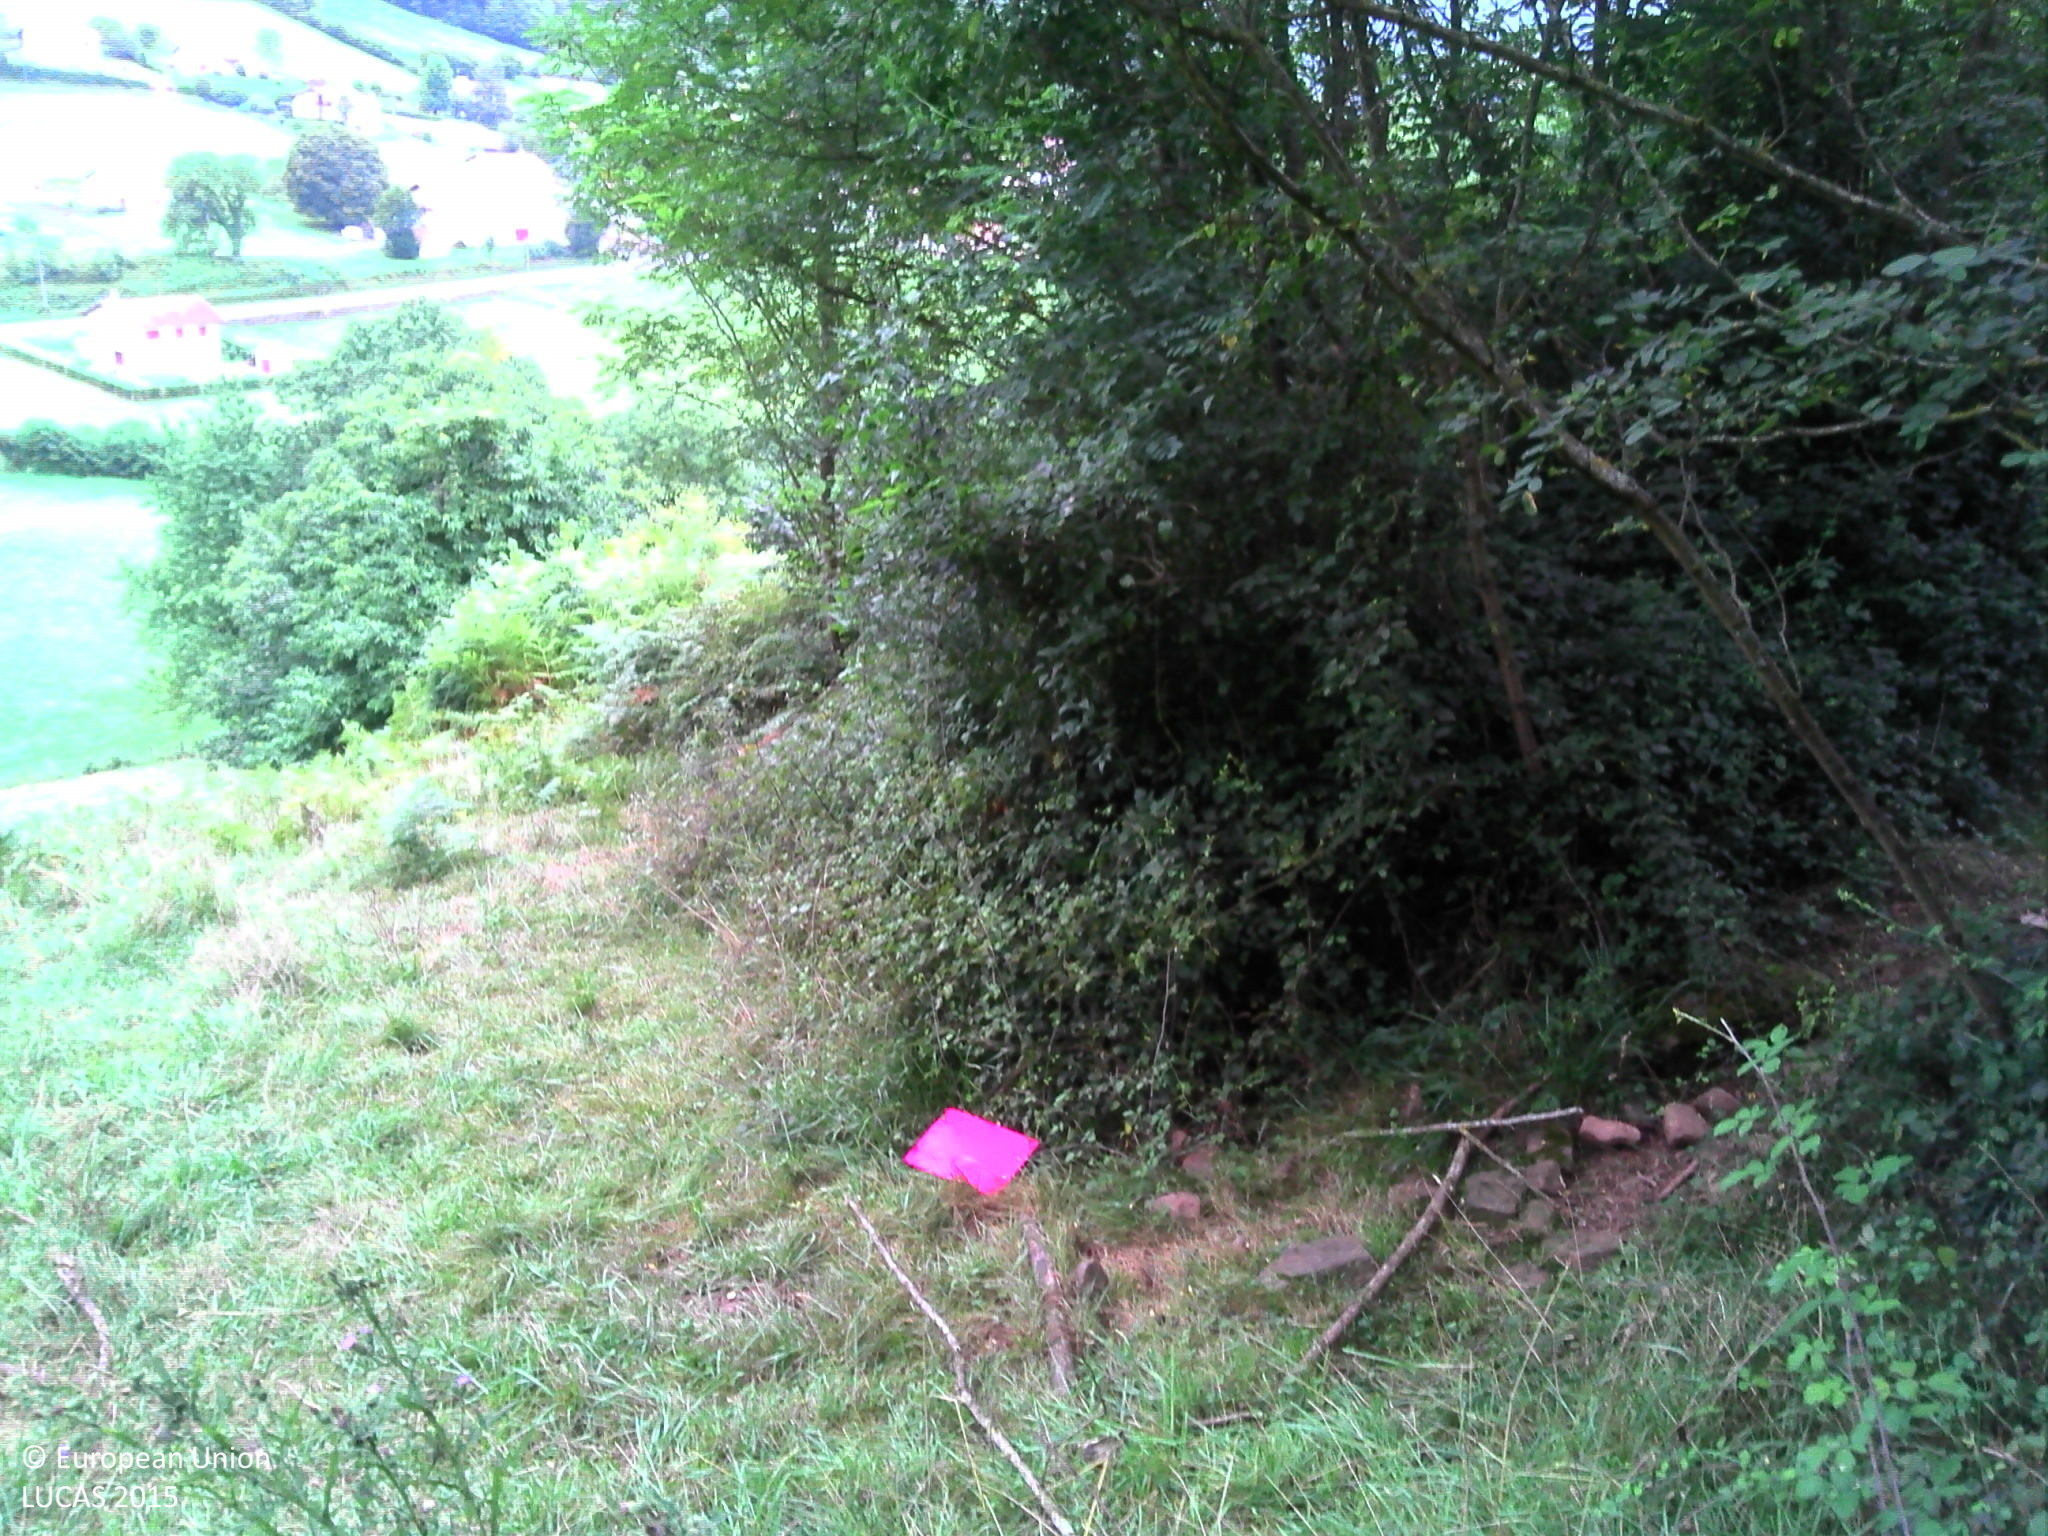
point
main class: Woodland
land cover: Broadleaved woodland
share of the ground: > 75 %
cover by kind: broadleaved forest trees 50 %, herbaceous plants 35 %, shrubs 15 %
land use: Forestry
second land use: Agriculture (excluding fallow land and kitchen gardens)
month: August
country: FR
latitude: 43.1828
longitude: -1.3210
